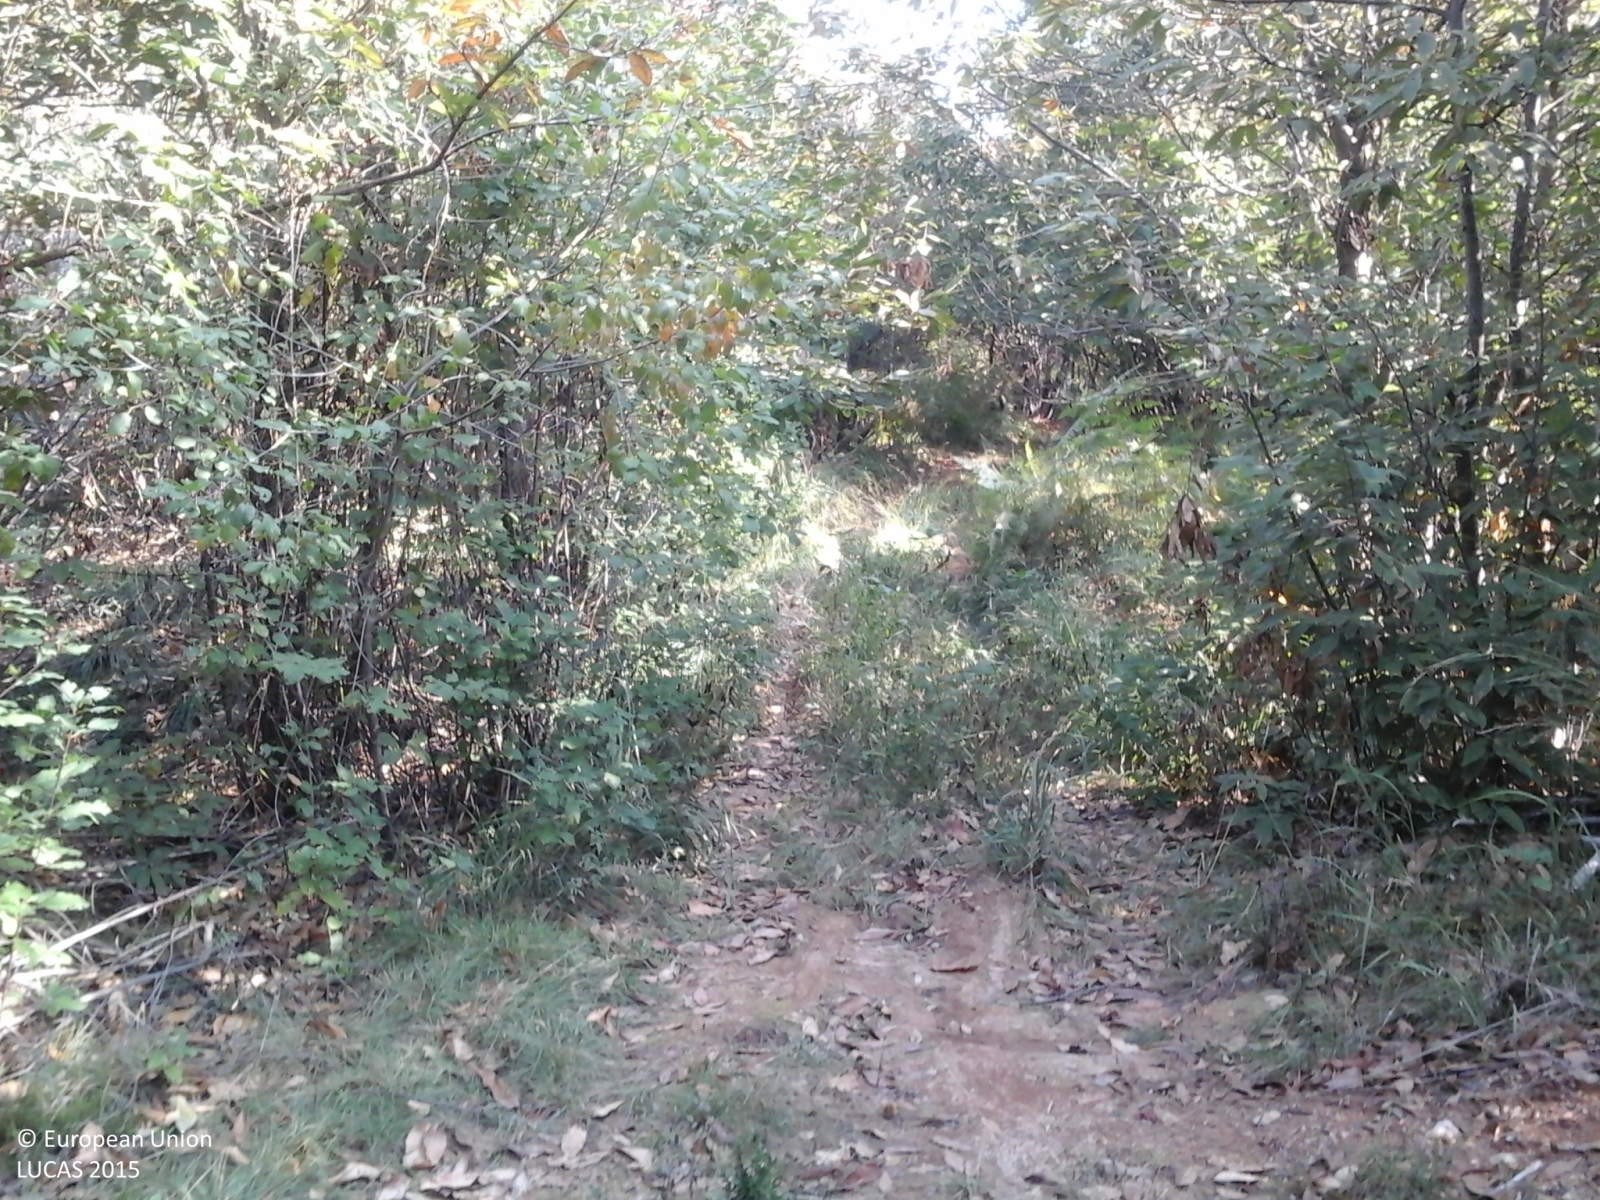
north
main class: Woodland
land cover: Broadleaved woodland
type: thermophilous deciduous forest
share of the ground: > 75 %
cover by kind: broadleaved forest trees 90 %, shrubs 5 %, herbaceous plants 5 %
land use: Semi-natural and natural areas not in use
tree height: > 5 m
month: September
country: IT
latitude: 44.3729
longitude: 8.3095
